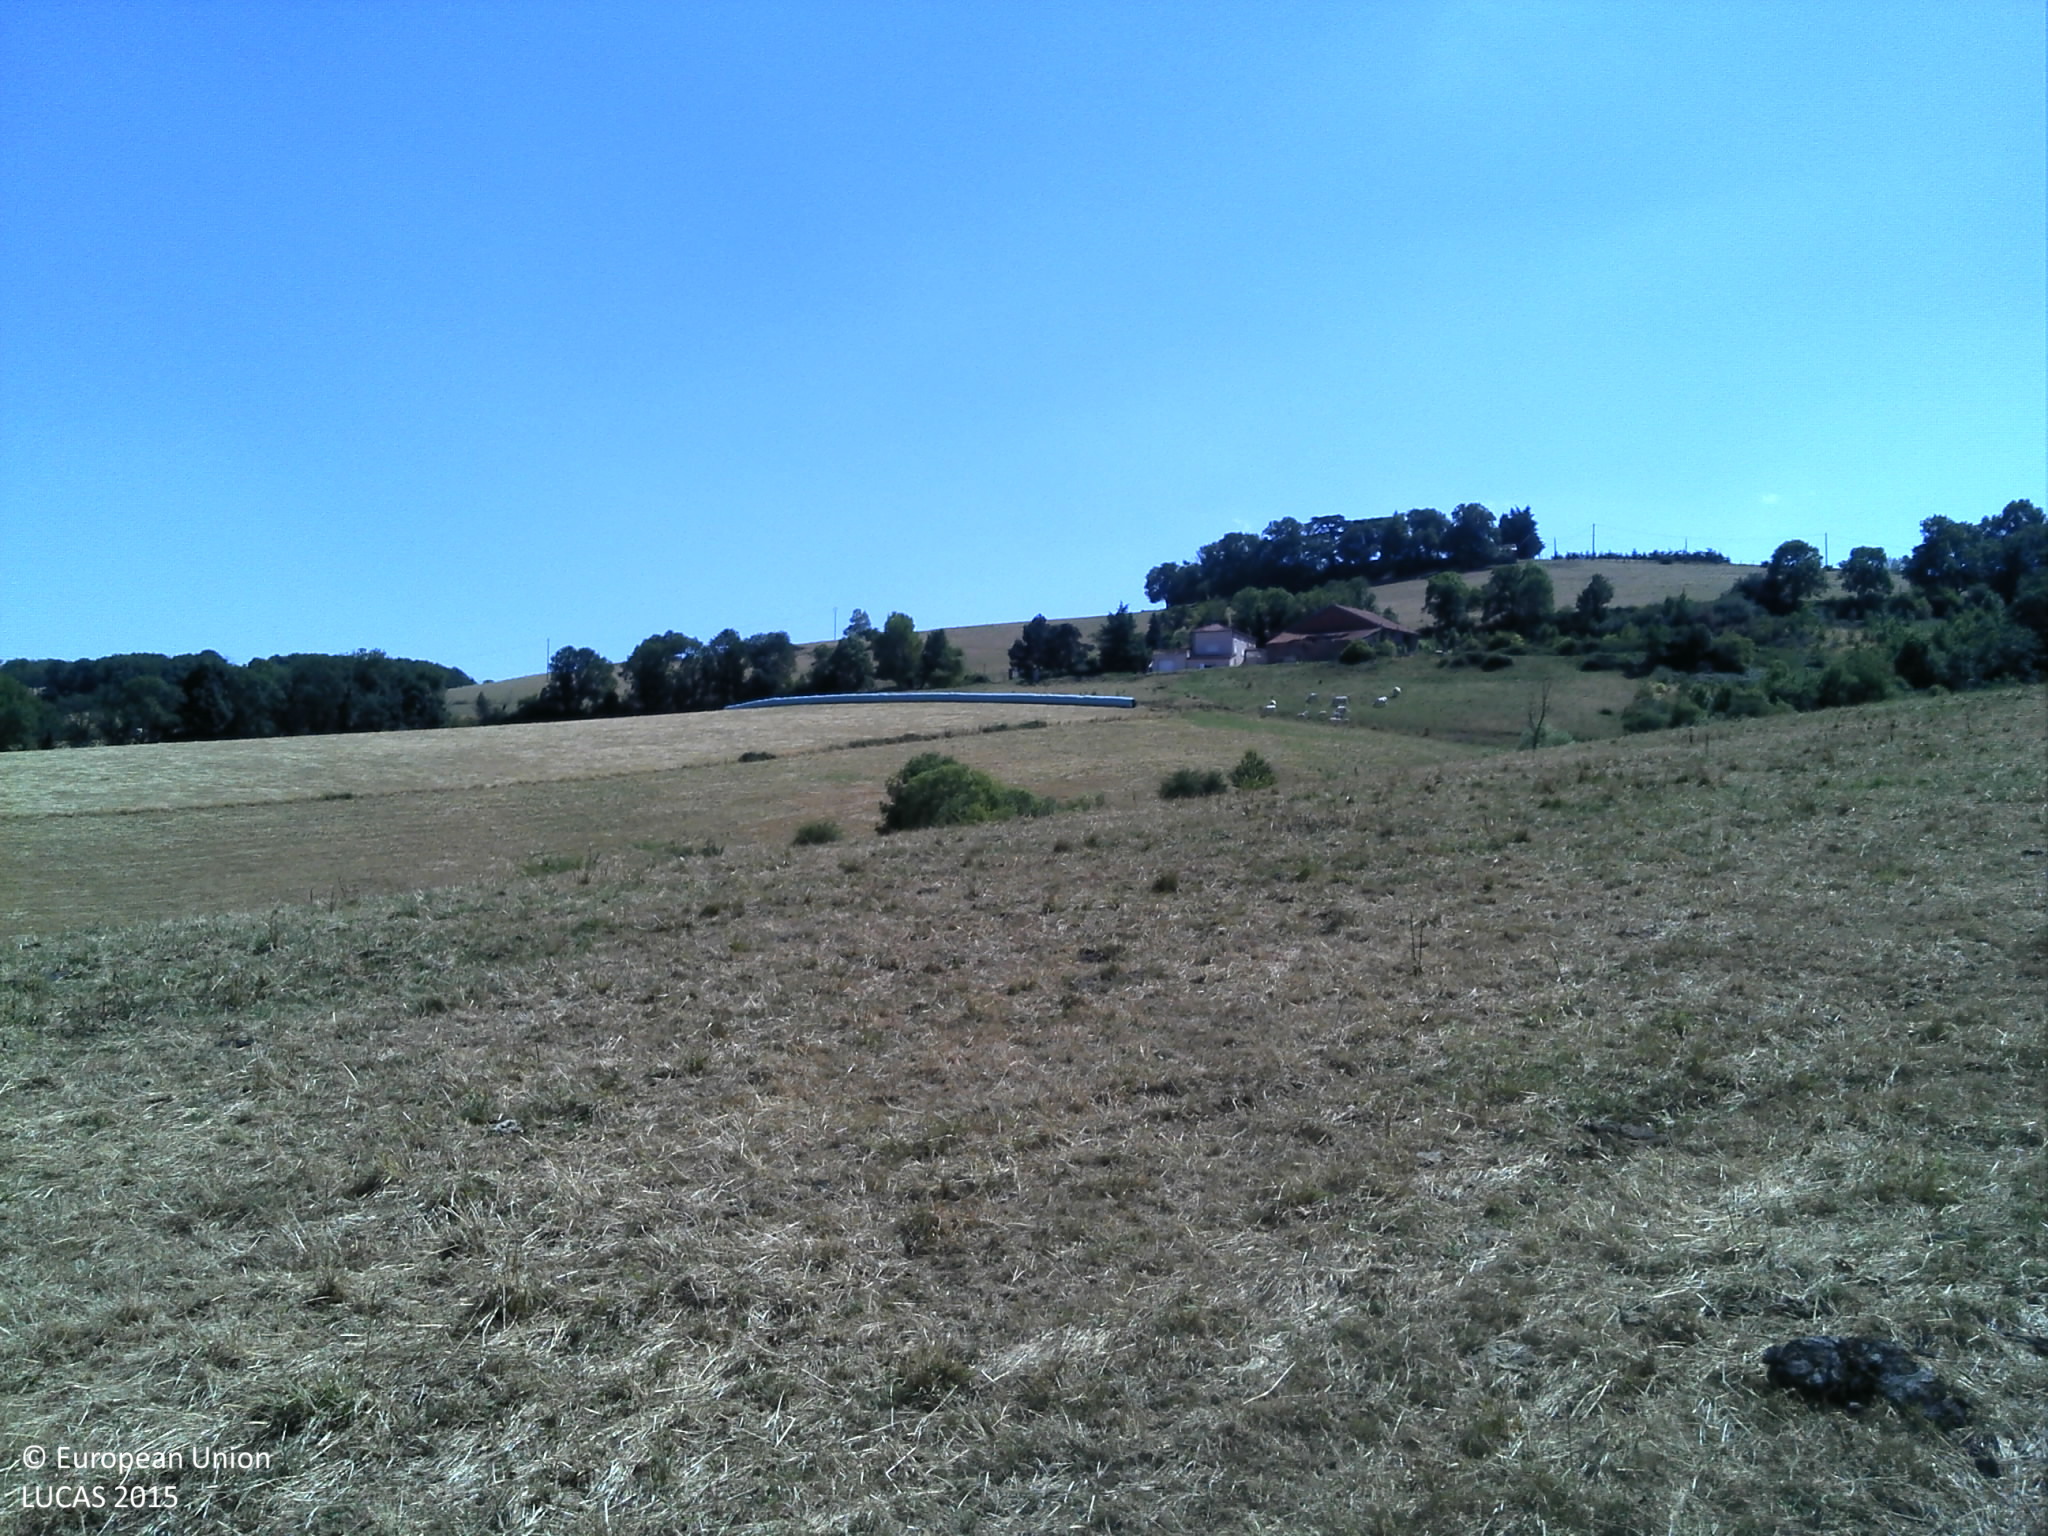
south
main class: Grassland
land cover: Grassland without tree/shrub cover
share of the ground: > 75 %
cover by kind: herbaceous plants 100 %
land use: Agriculture (excluding fallow land and kitchen gardens)
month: July
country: FR
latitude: 45.9539
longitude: 4.1058
